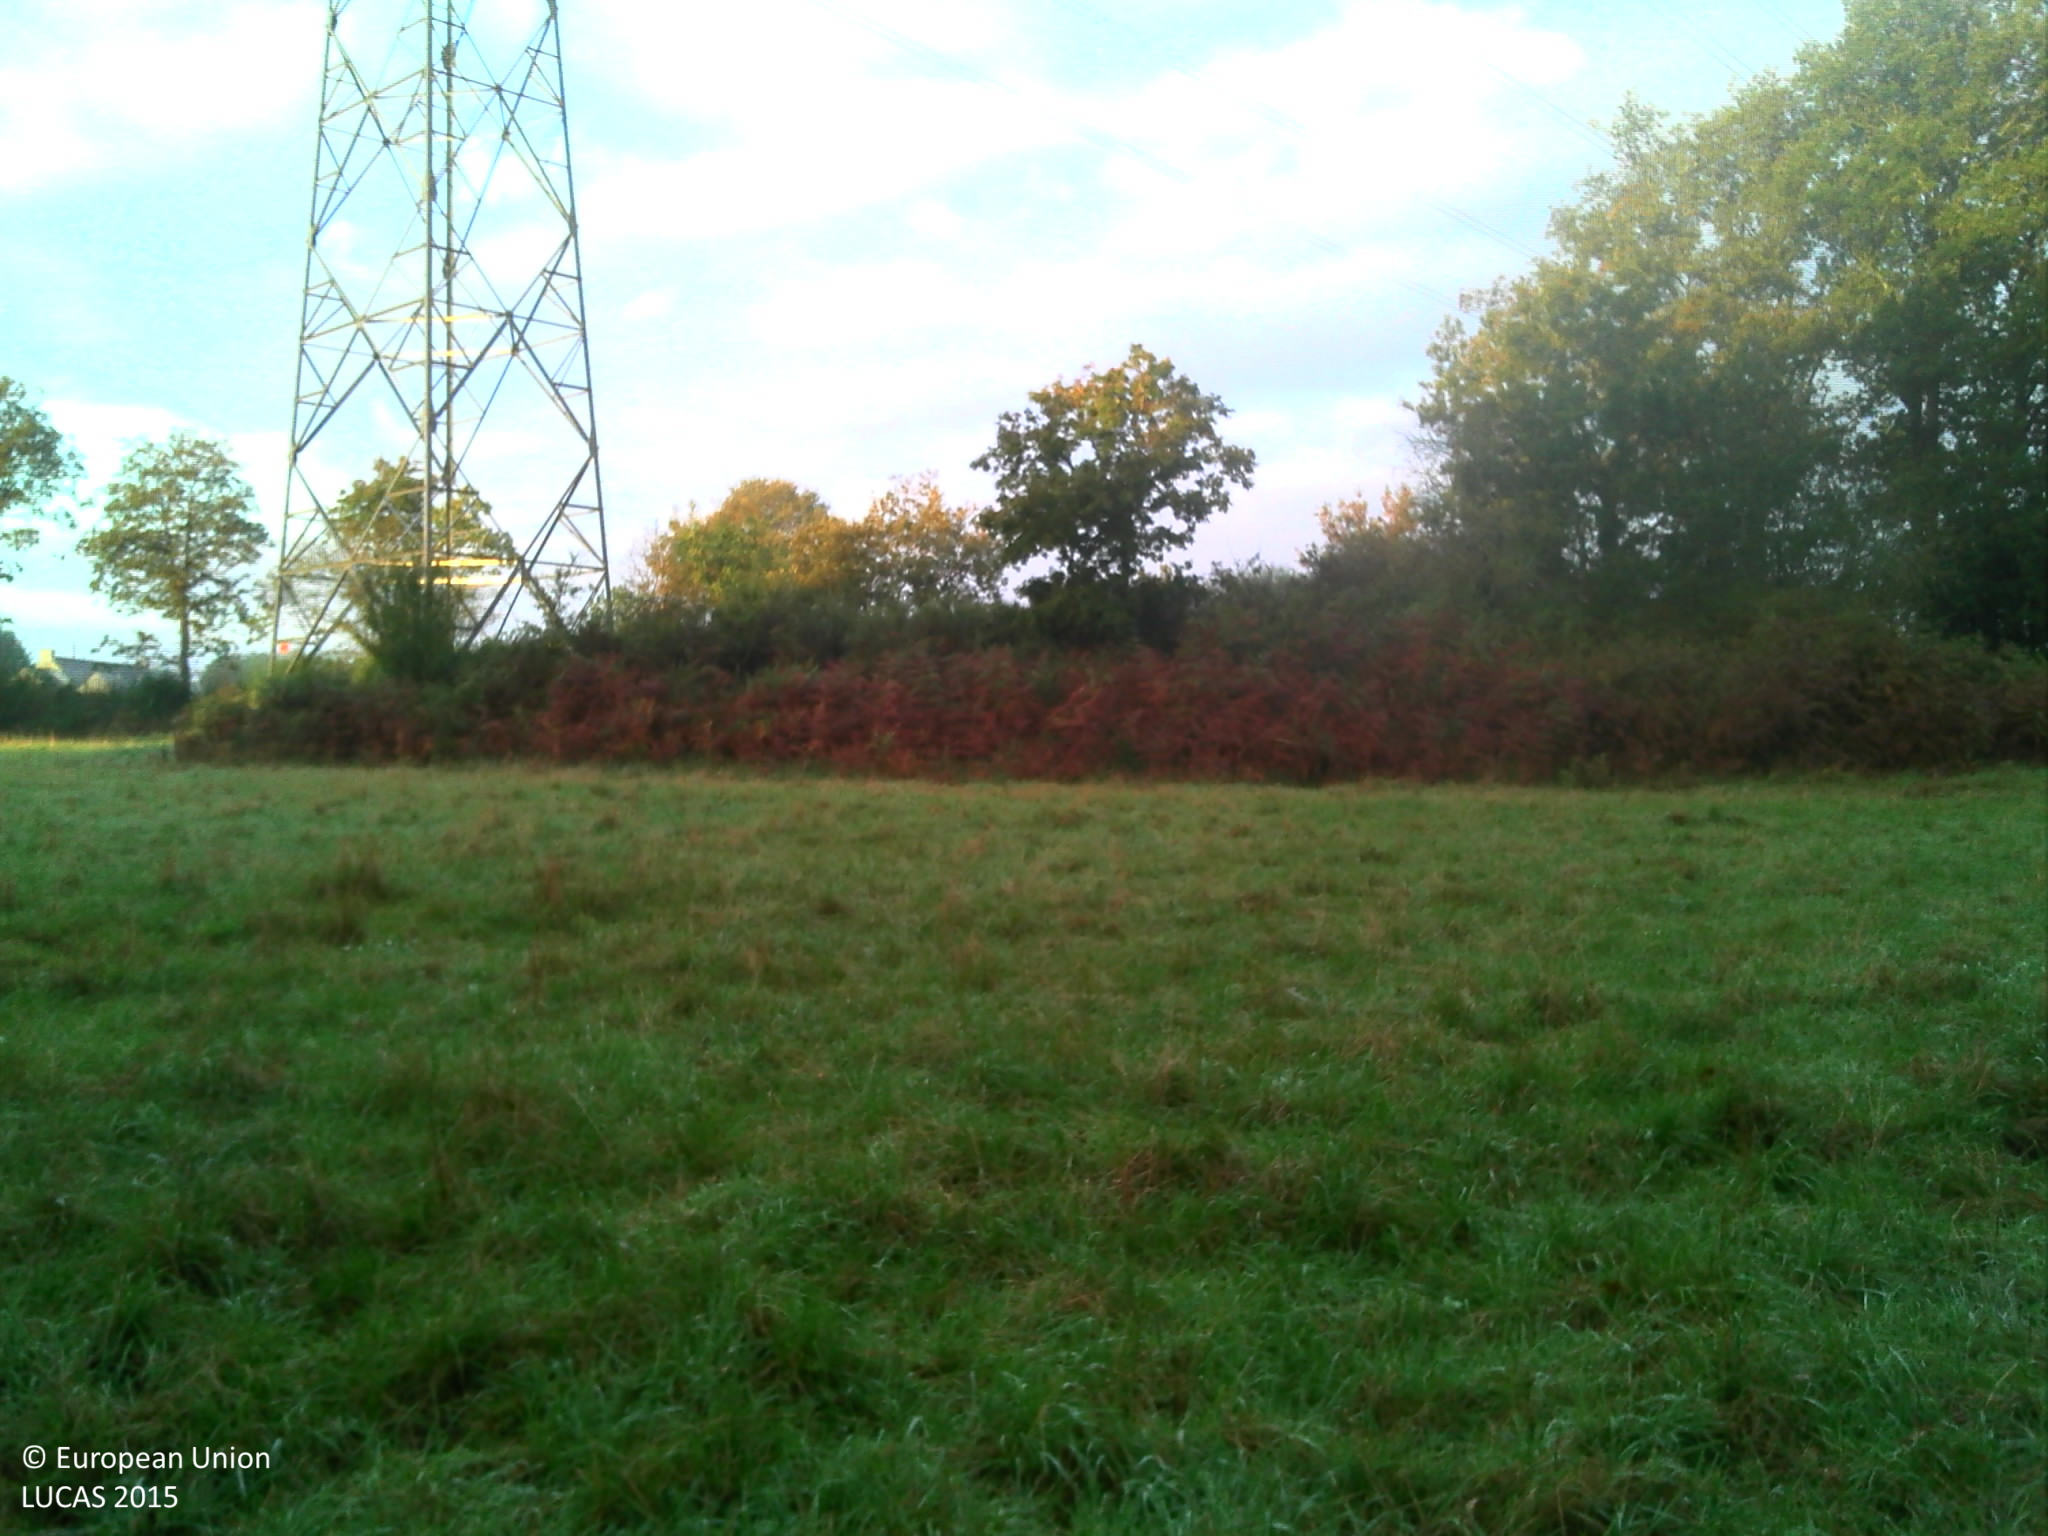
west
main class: Grassland
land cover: Spontaneously vegetated surfaces
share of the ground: > 75 %
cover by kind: herbaceous plants 95 %, shrubs 5 %
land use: Semi-natural and natural areas not in use
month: October
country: FR
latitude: 47.6600
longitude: -2.2917
